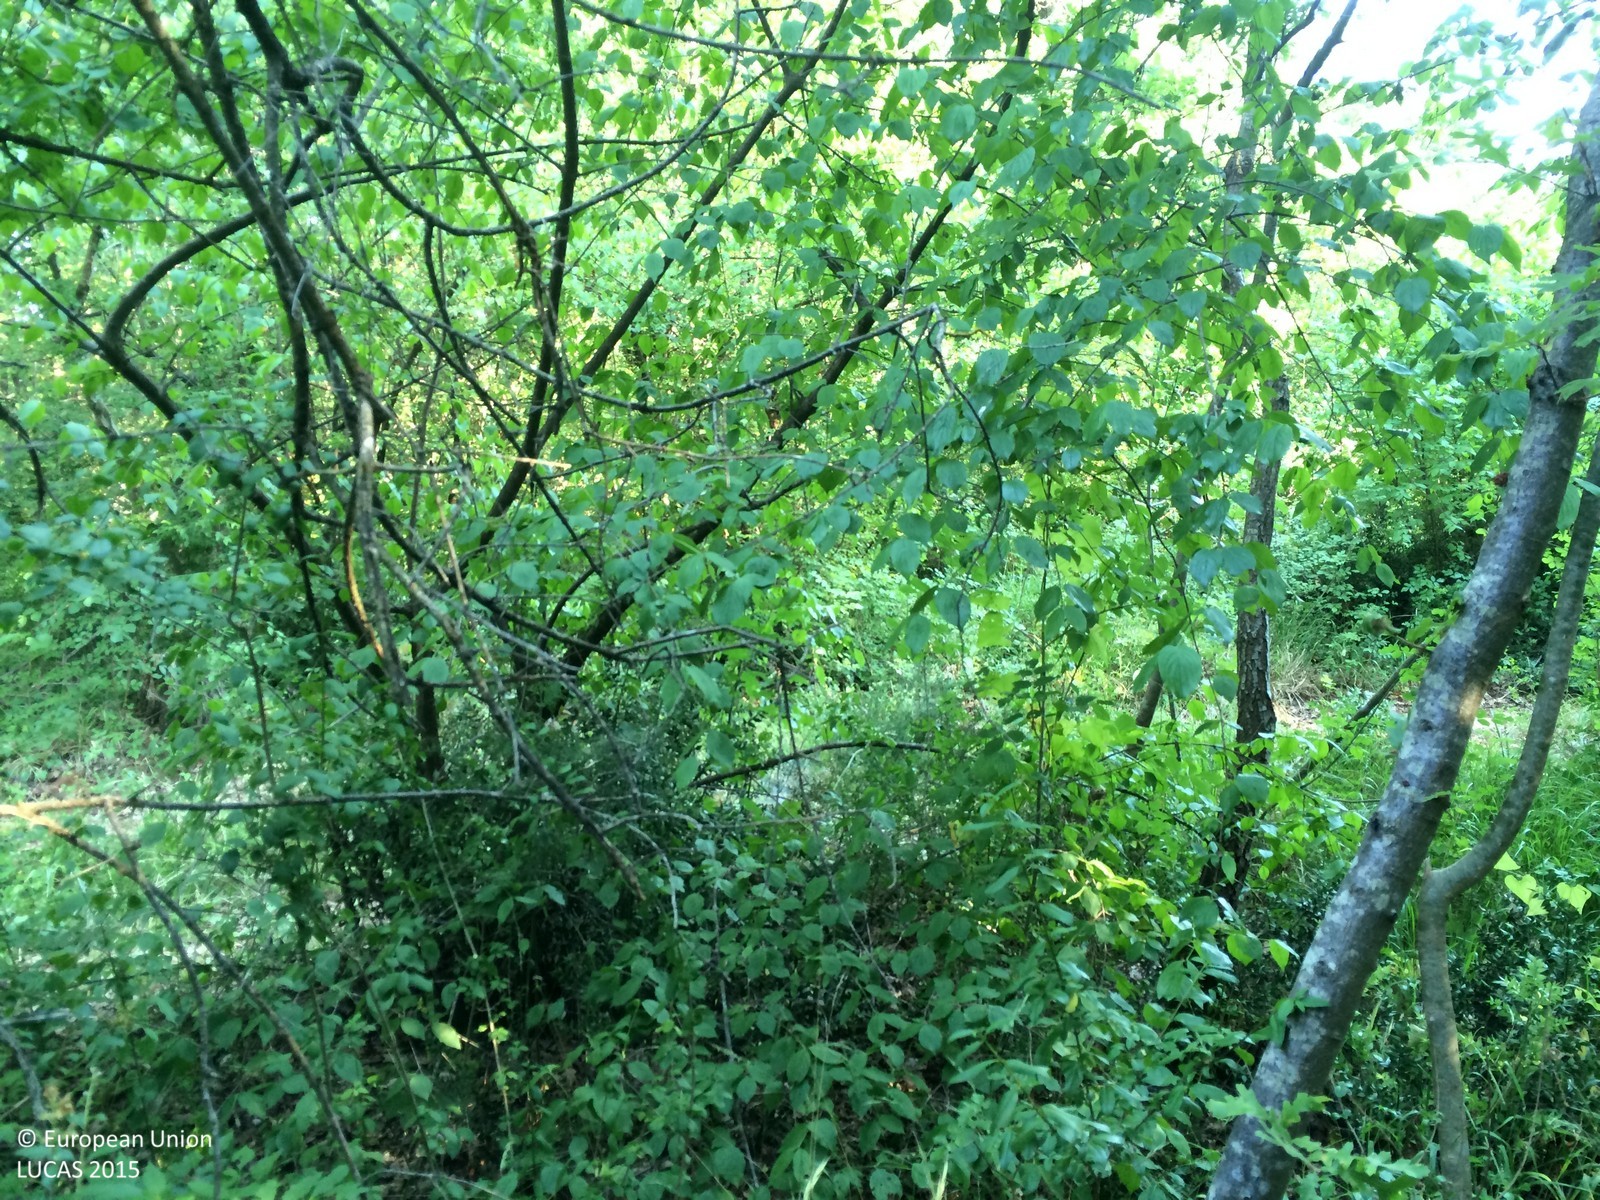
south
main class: Woodland
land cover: Broadleaved woodland
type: mesophytic deciduous forest
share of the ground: > 75 %
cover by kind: broadleaved forest trees 90 %, shrubs 10 %
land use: Semi-natural and natural areas not in use
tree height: > 5 m
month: June
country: HR
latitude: 45.0196
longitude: 13.8395
